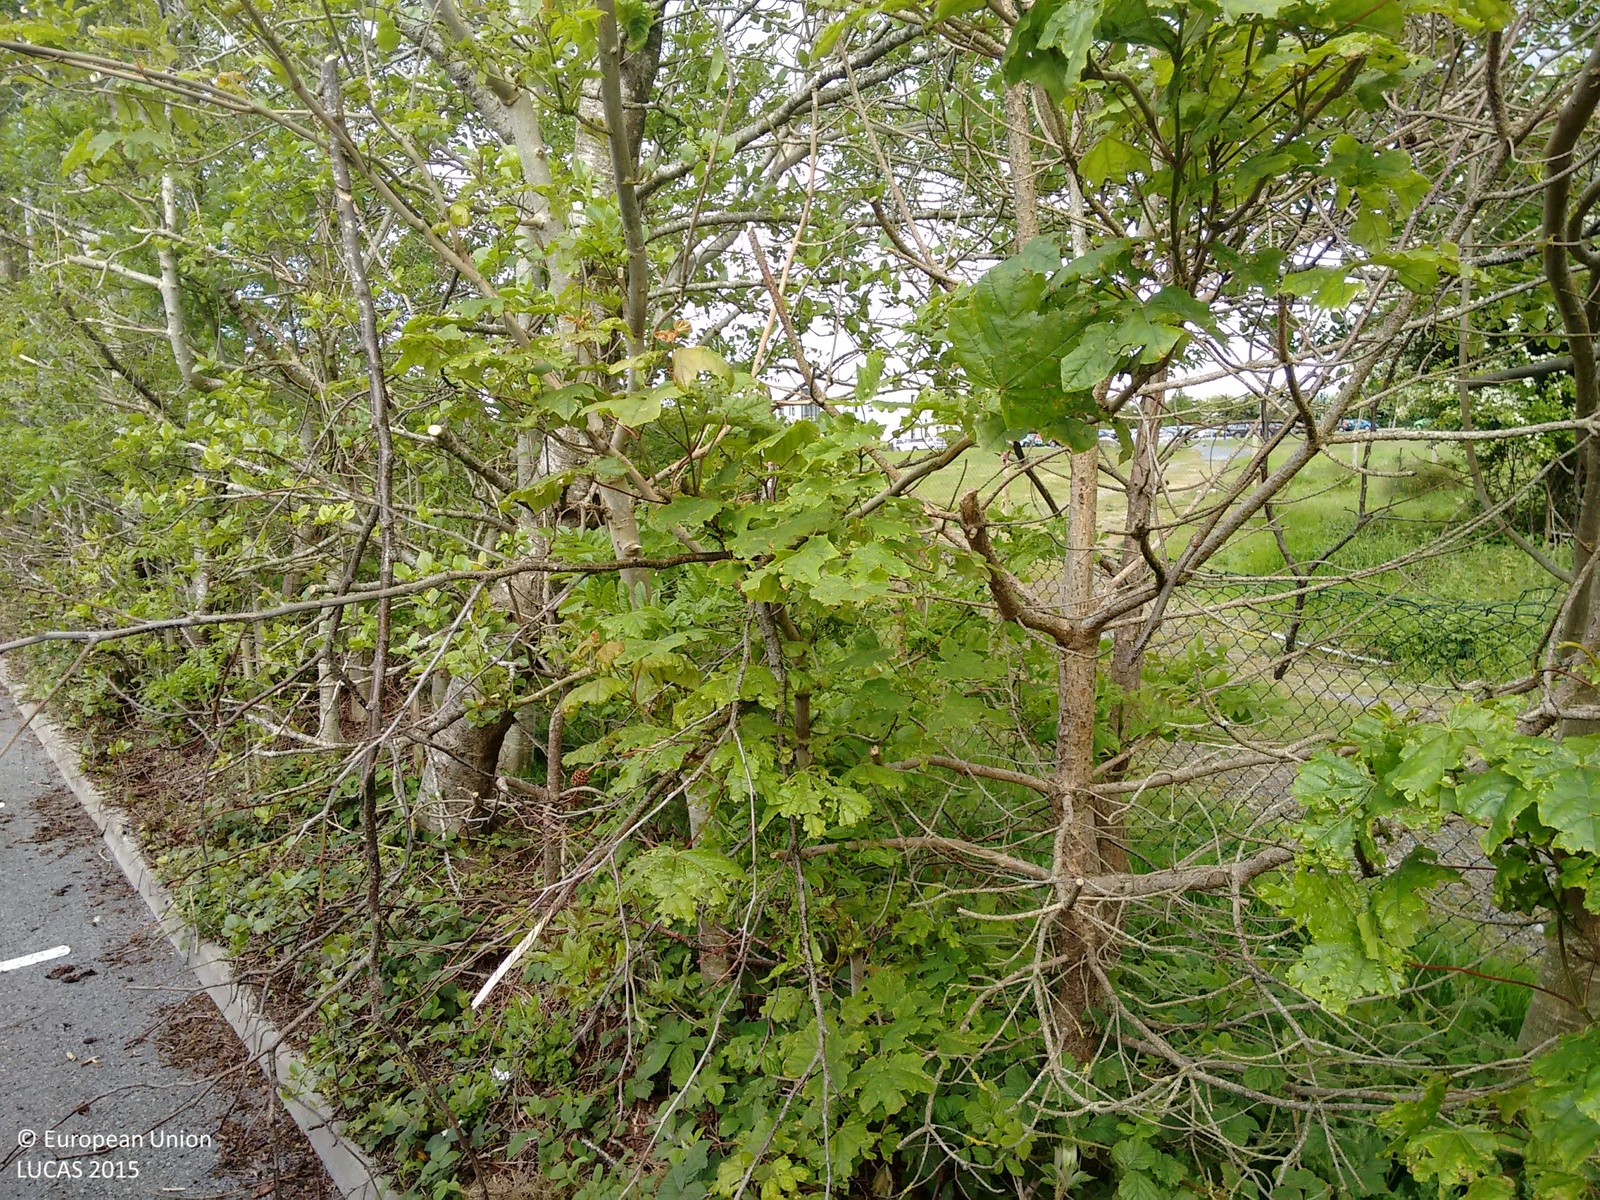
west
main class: Shrubland
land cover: Shrubland without tree cover
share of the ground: > 75 %
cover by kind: herbaceous plants 70 %, shrubs 30 %
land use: Semi-natural and natural areas not in use
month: May
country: IE
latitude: 53.3041
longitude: -8.9849
